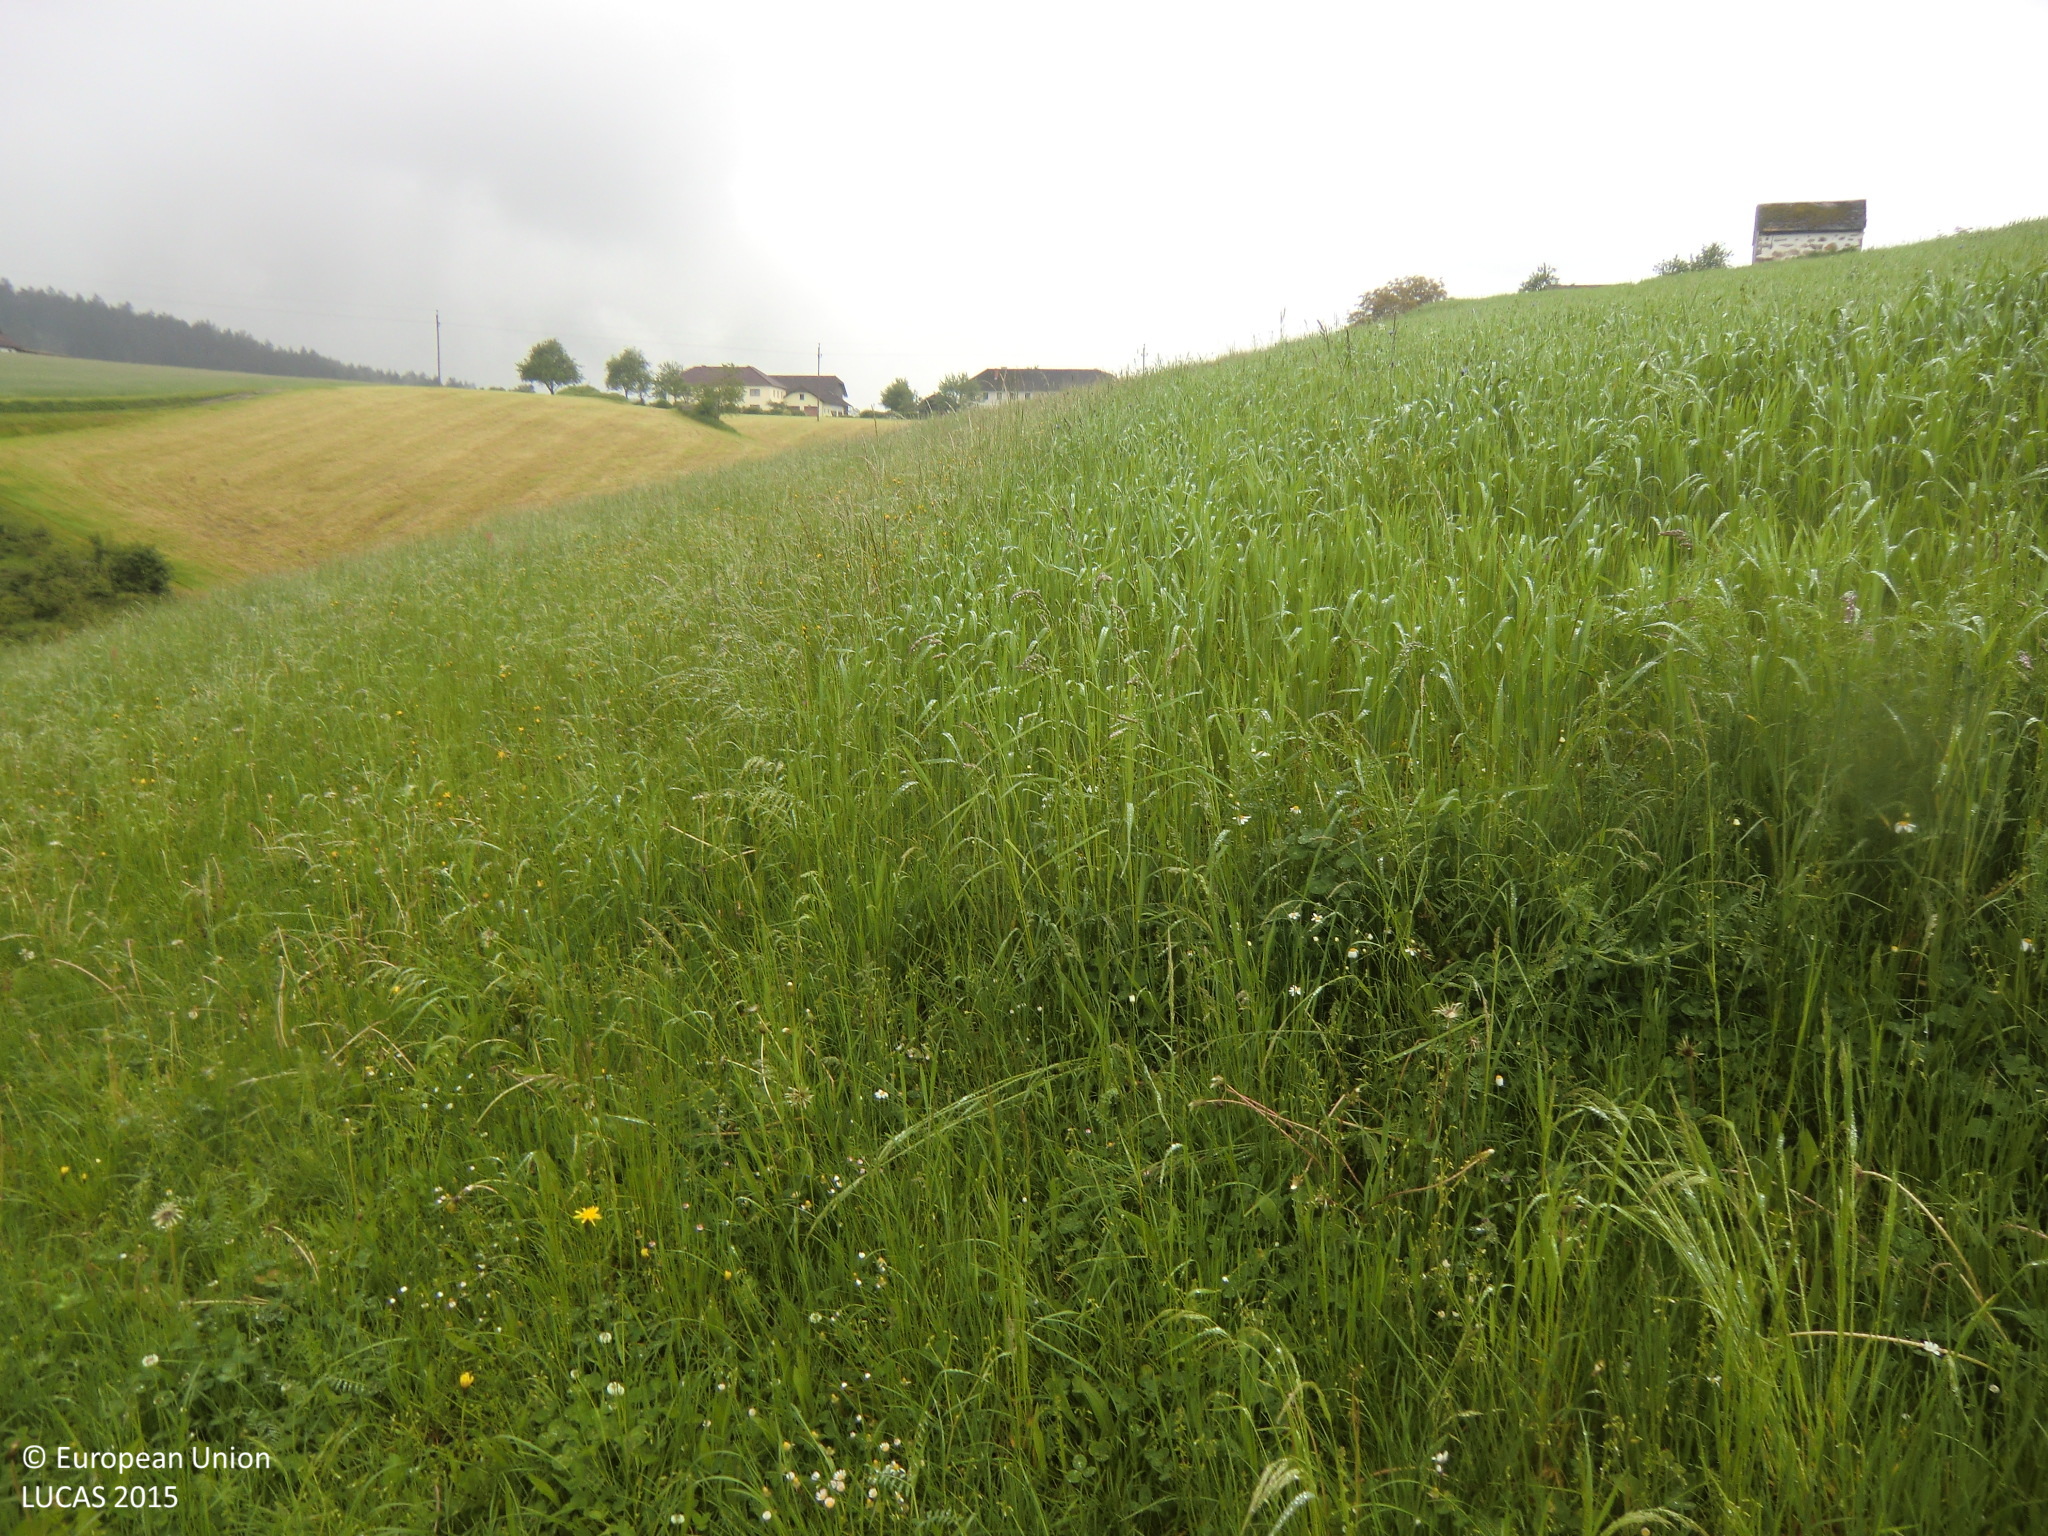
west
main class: Grassland
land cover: Grassland without tree/shrub cover
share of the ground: > 75 %
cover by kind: herbaceous plants 100 %
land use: Agriculture (excluding fallow land and kitchen gardens)
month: May
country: AT
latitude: 48.3752
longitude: 14.7126
